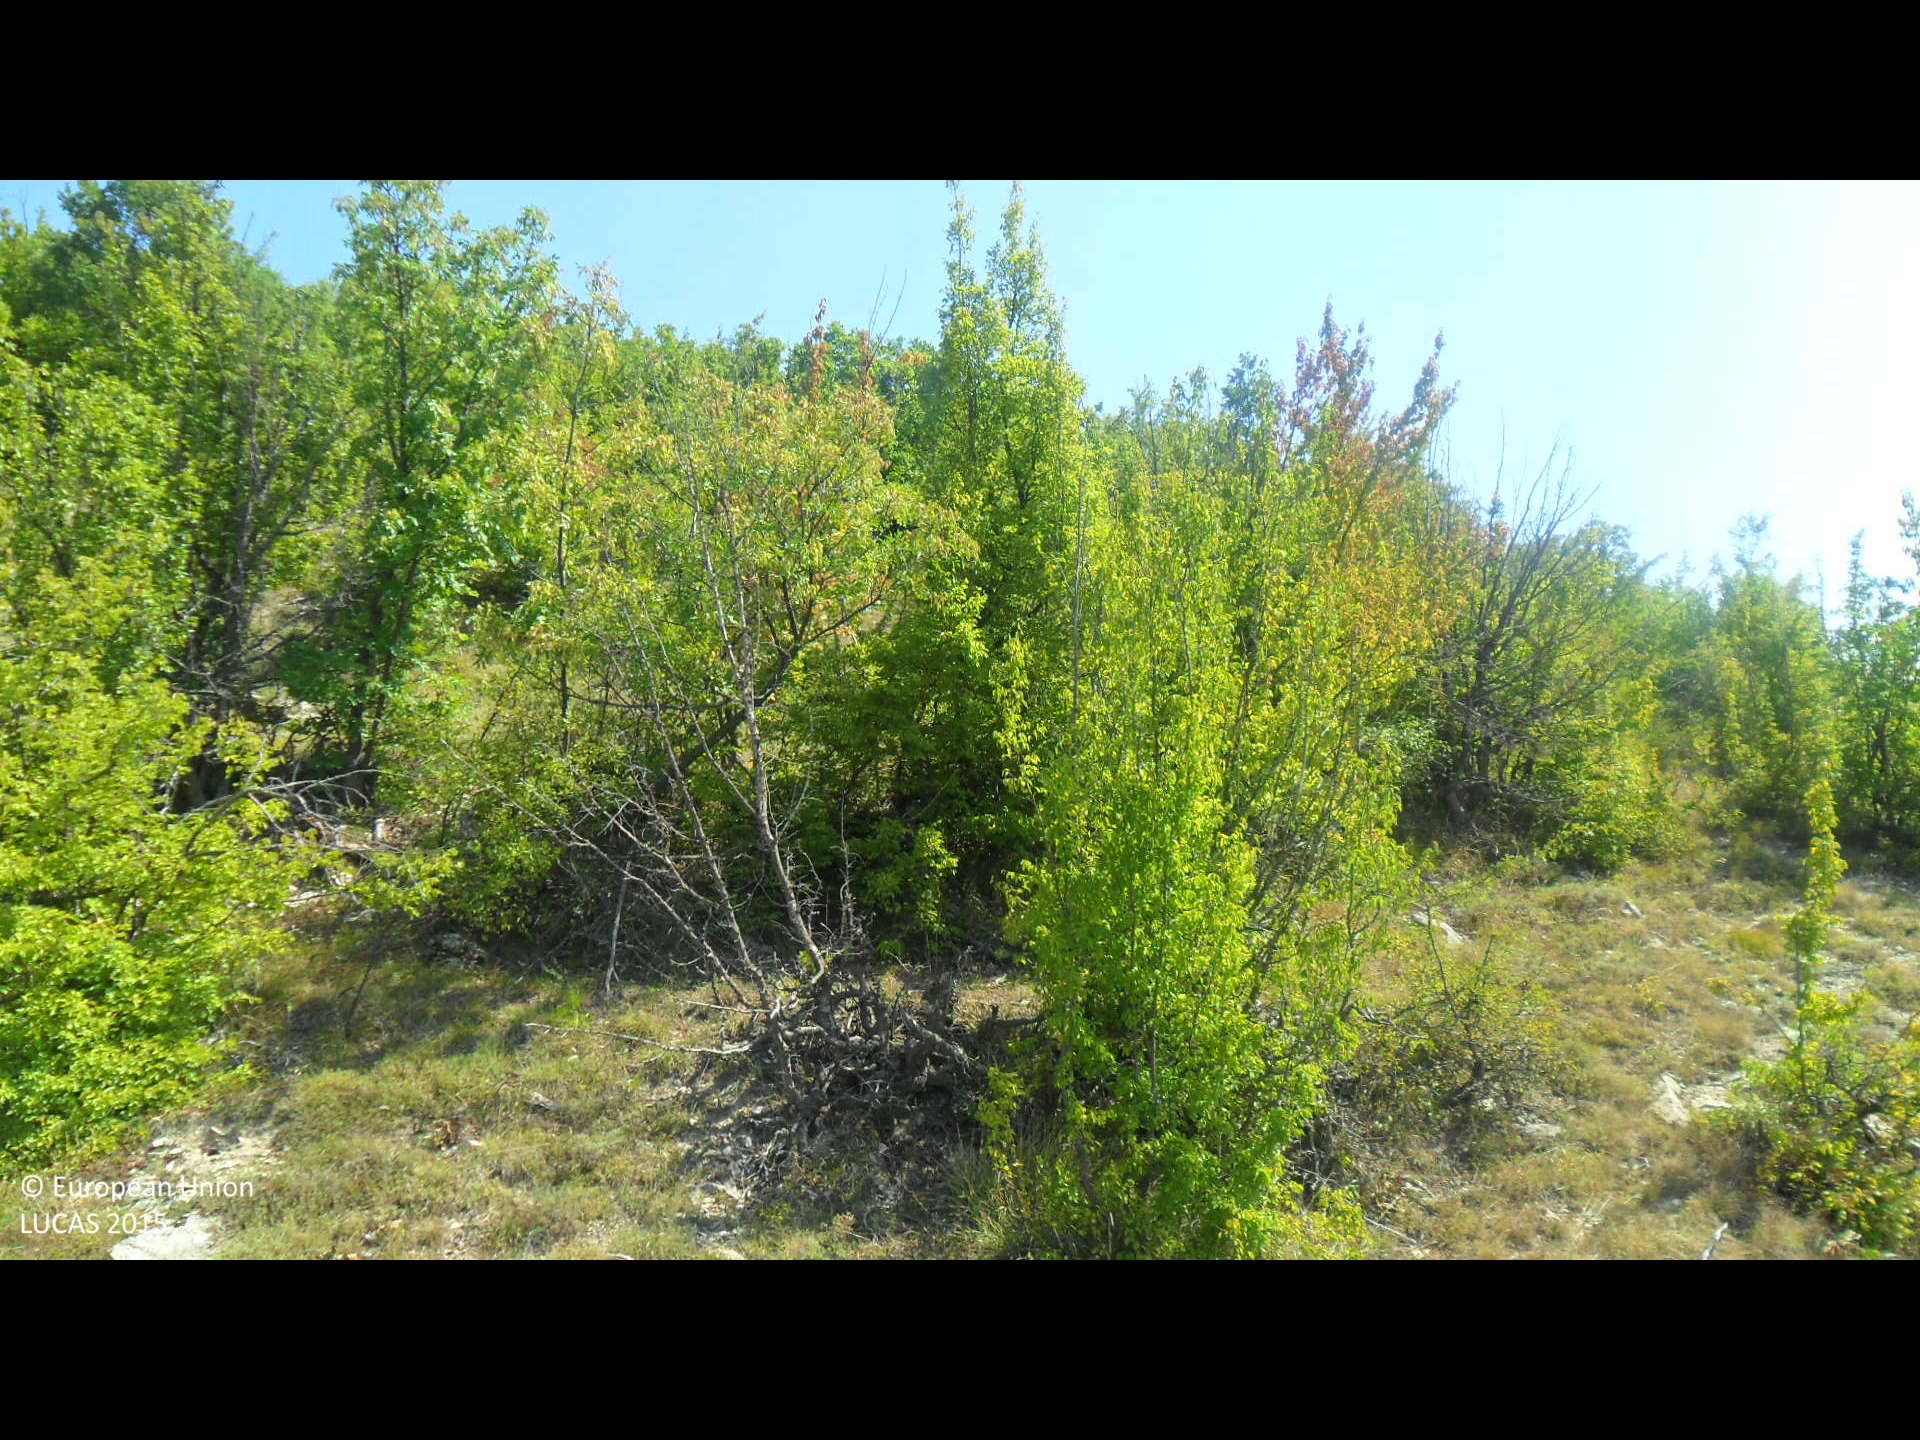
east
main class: Woodland
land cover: Broadleaved woodland
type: thermophilous deciduous forest
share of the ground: > 75 %
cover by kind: broadleaved forest trees 95 %, unconsolidated bare surface 5 %
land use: Forestry
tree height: > 5 m
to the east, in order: Broadleaved woodland; Tracks; Broadleaved woodland; Rivers and streams; Broadleaved woodland
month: September
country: BG
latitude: 43.1465
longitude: 26.6168
